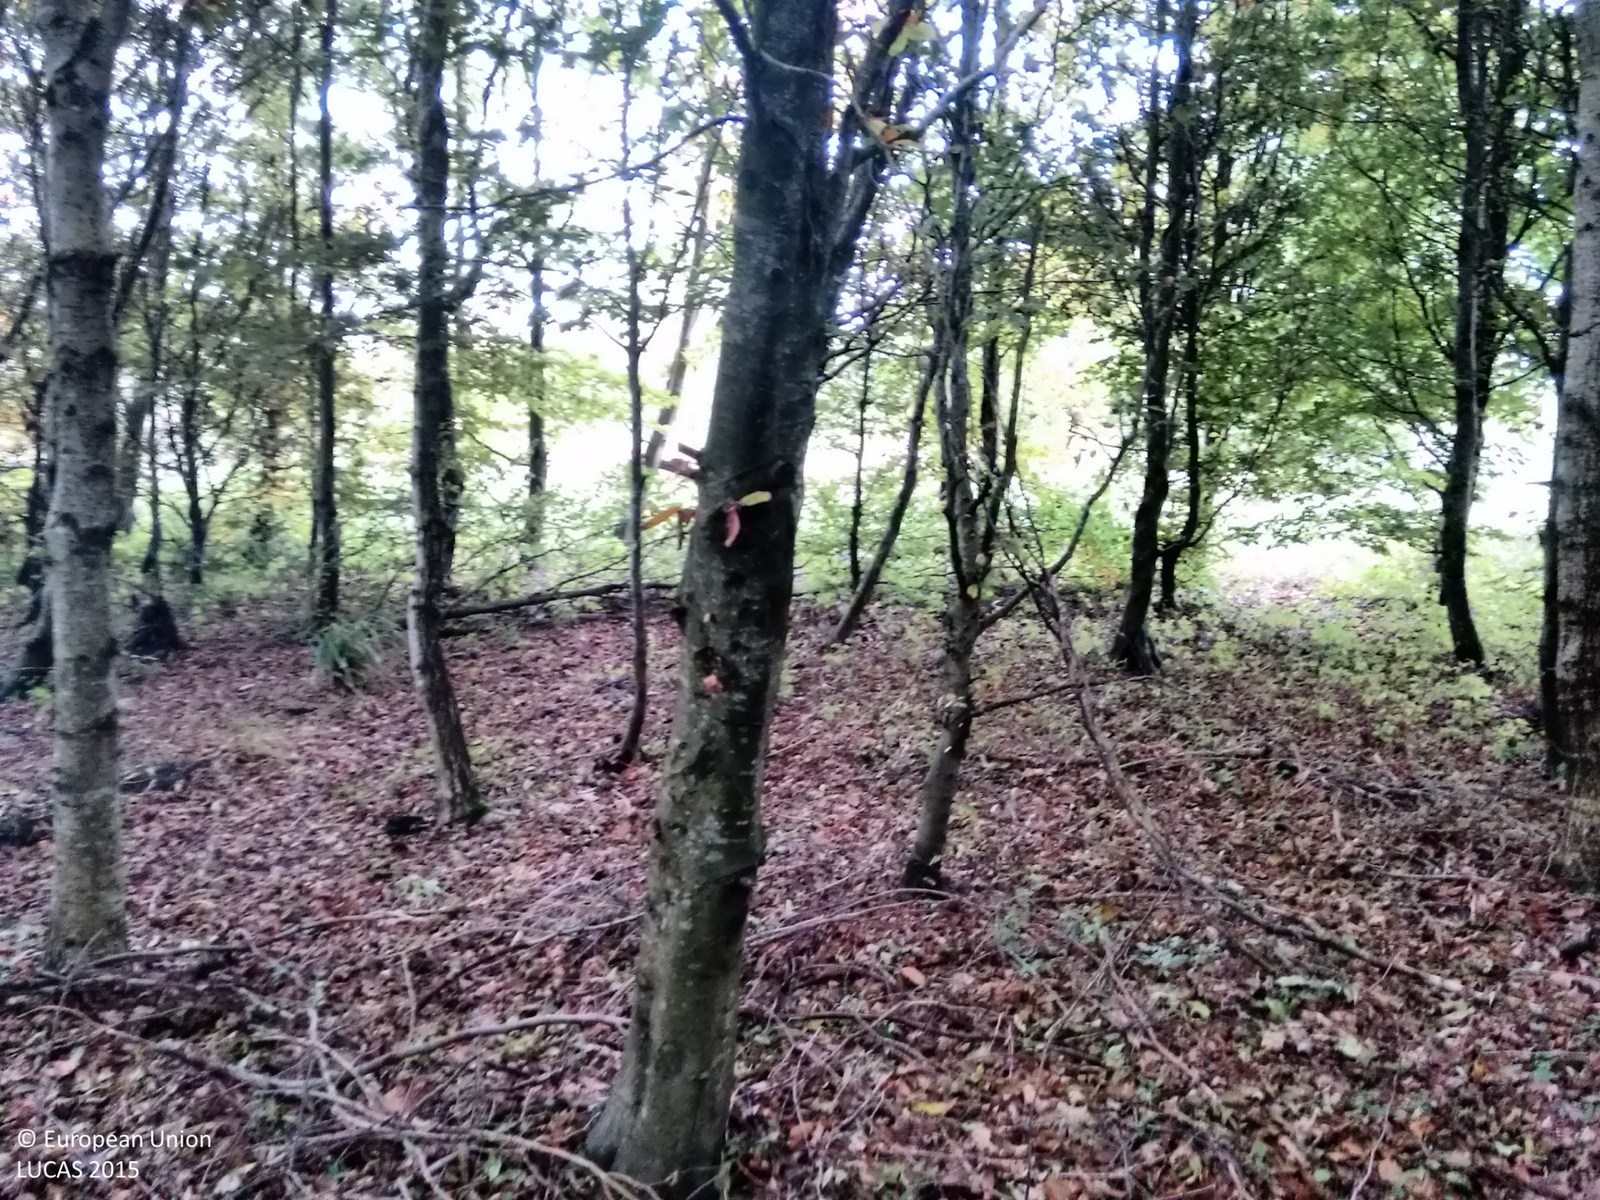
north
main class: Woodland
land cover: Broadleaved woodland
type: mesophytic deciduous forest
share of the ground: > 75 %
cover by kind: broadleaved forest trees 100 %
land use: Forestry
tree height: > 5 m
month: October
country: IE
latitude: 53.1033
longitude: -7.7778
